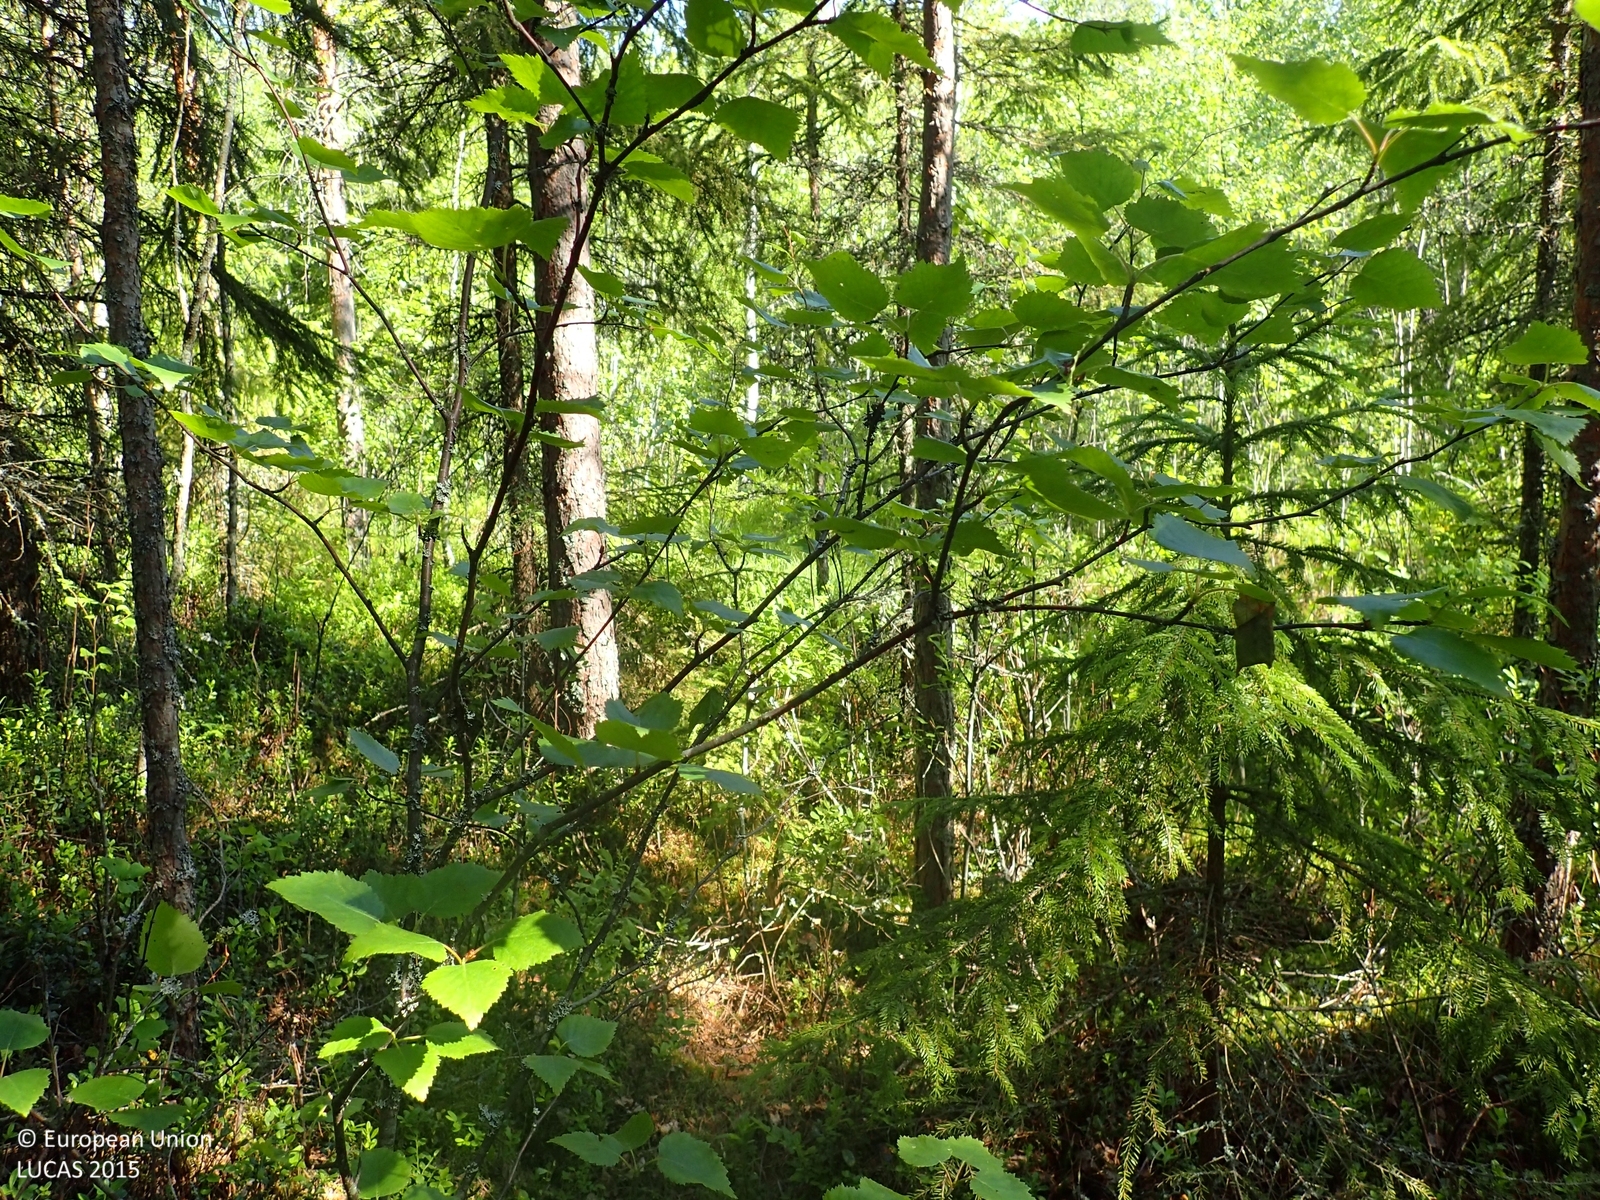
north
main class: Woodland
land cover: Pine dominated coniferous woodland
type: boreal forest
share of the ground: 50 - 75 %
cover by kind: coniferous forest trees 50 %, shrubs 40 %, broadleaved forest trees 10 %
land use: Forestry
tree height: > 5 m
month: July
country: FI
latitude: 62.6987
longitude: 21.5135
